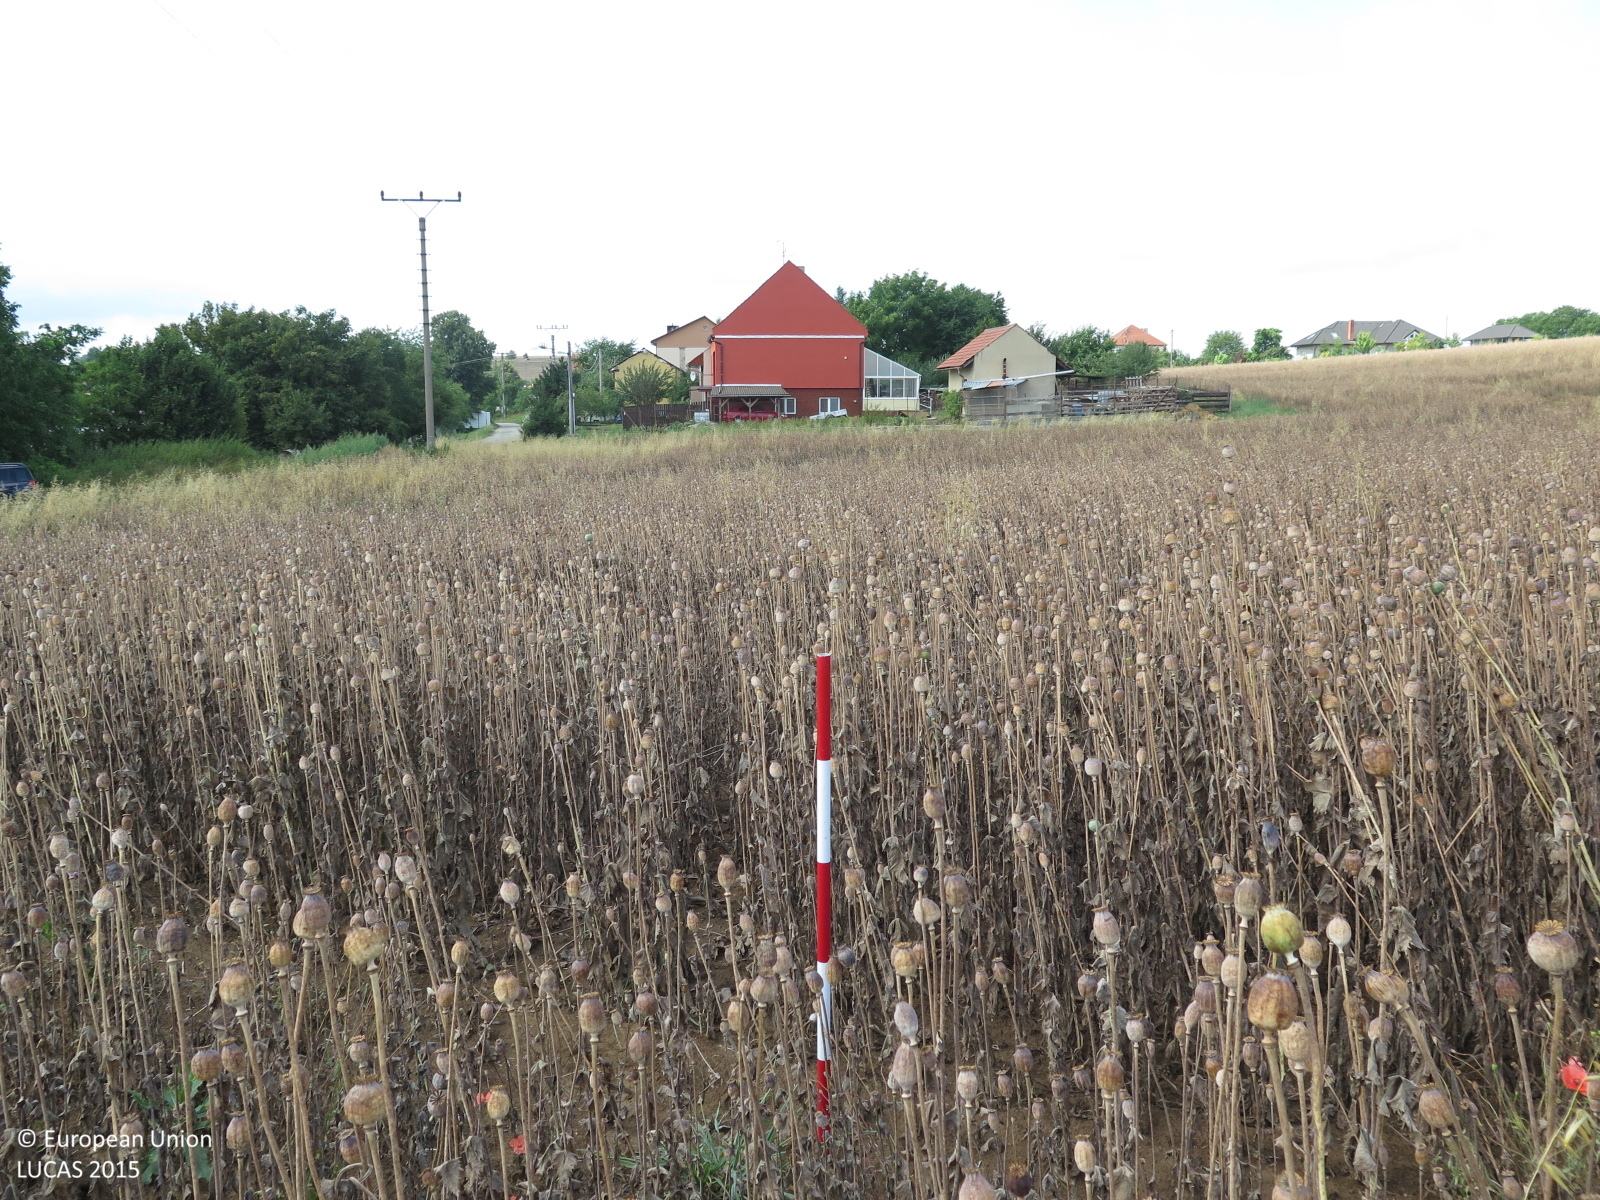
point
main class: Cropland
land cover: Other fibre and oleaginous crops
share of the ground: > 75 %
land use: Agriculture (excluding fallow land and kitchen gardens)
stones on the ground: < 10 %
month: July
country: CZ
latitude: 49.1022
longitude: 17.5589
